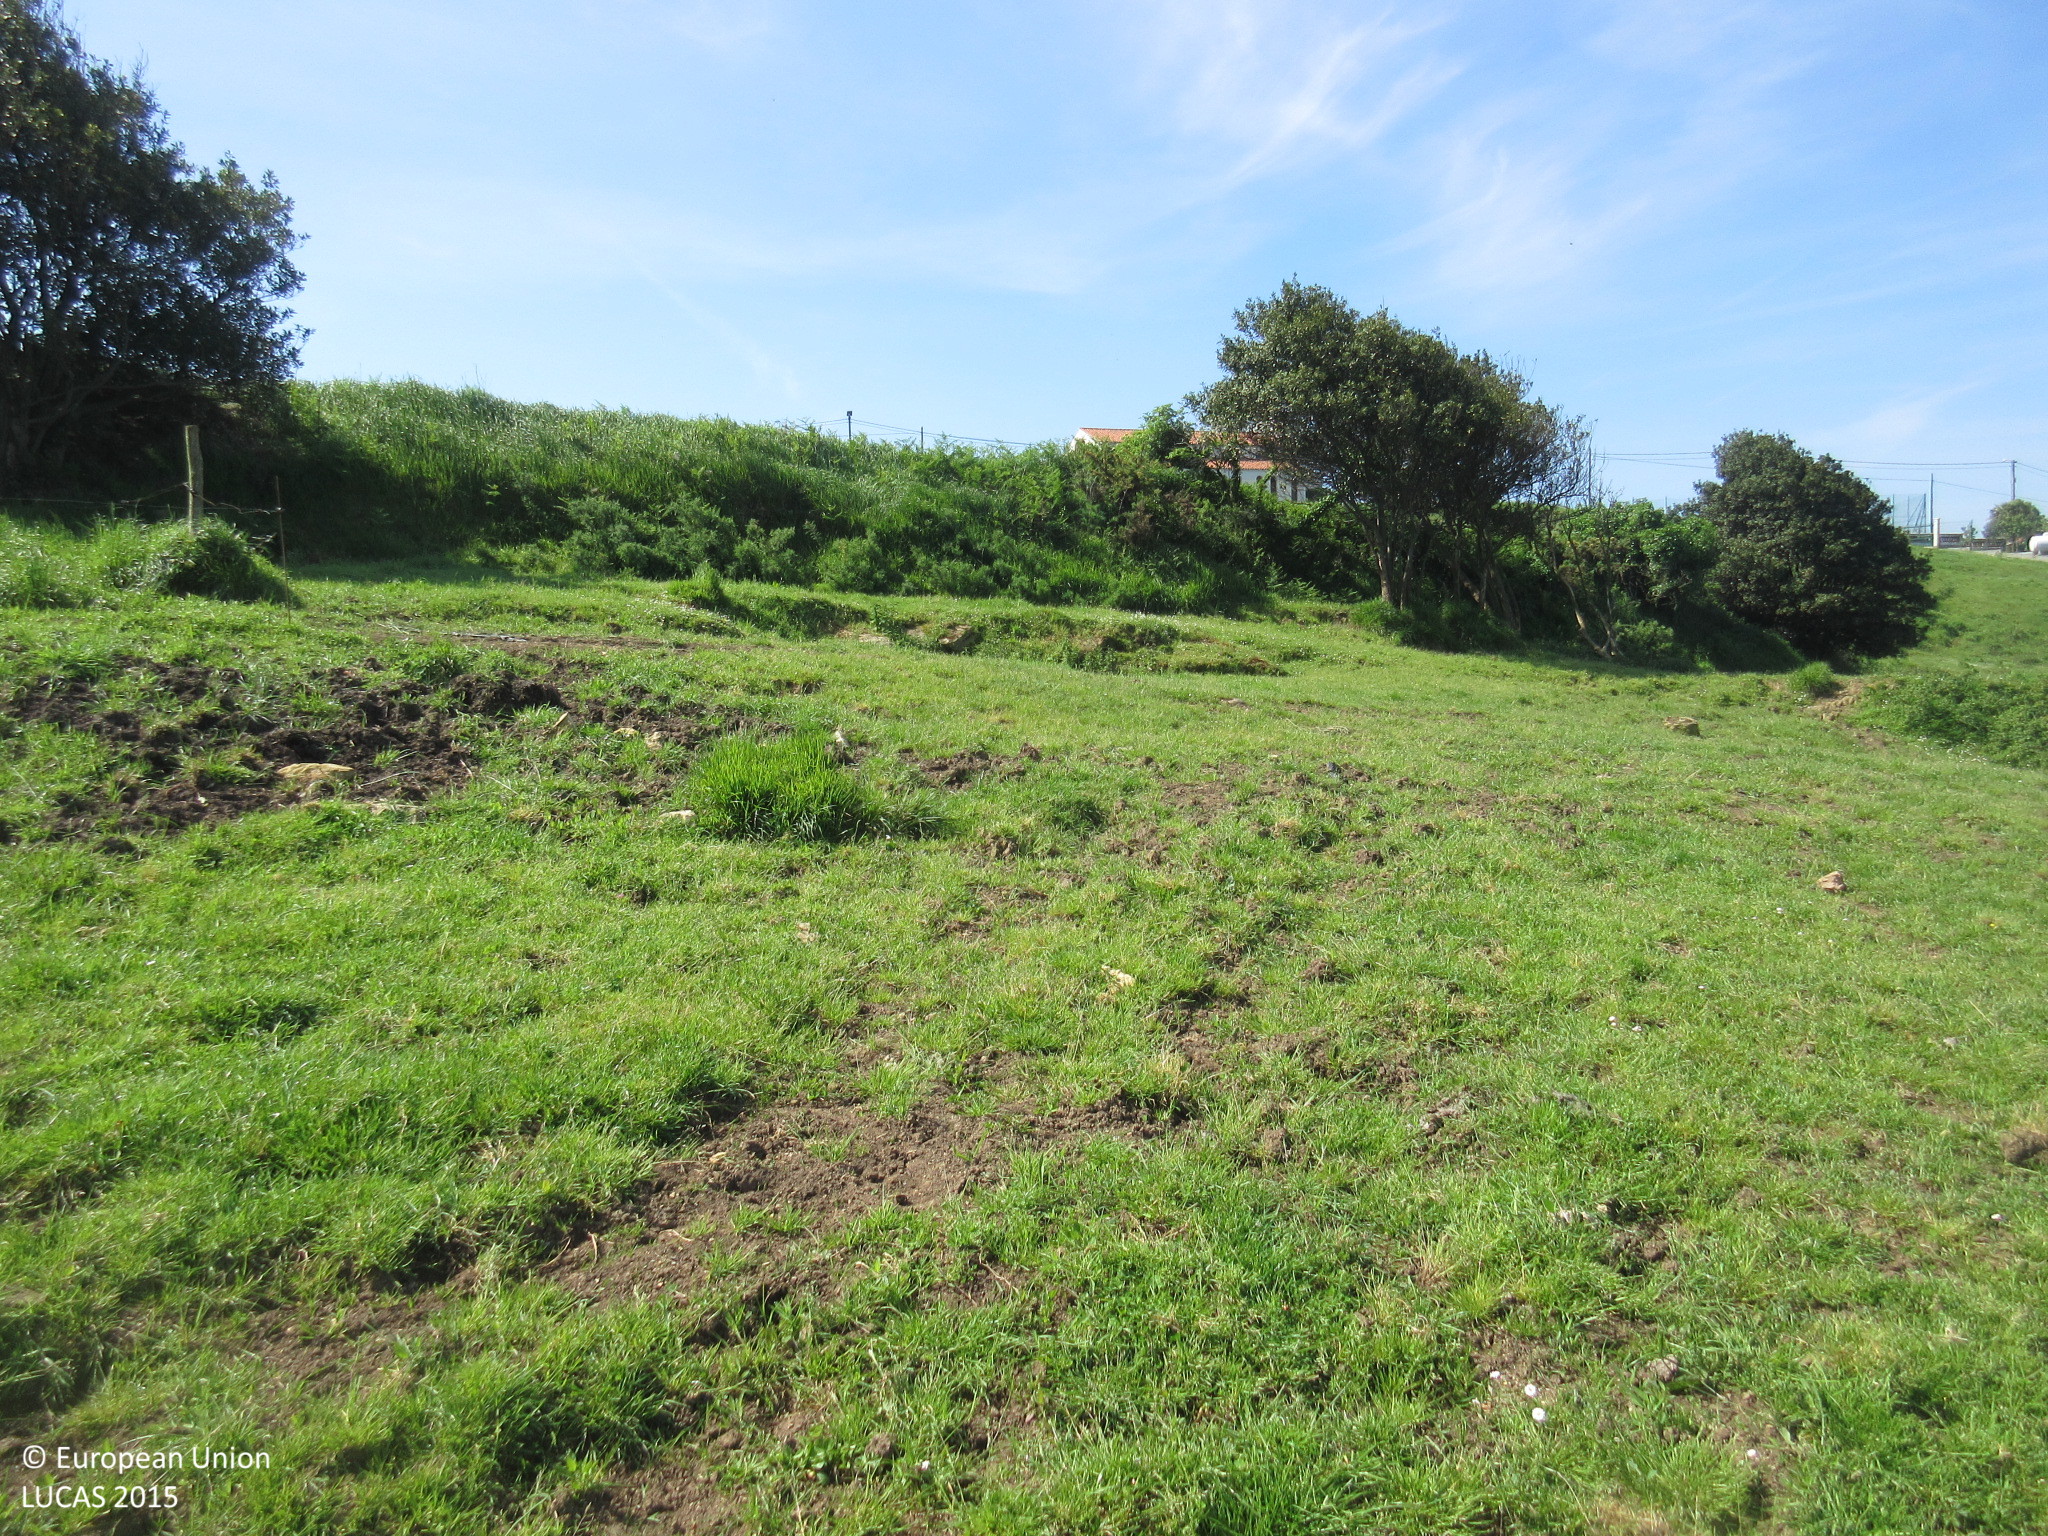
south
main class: Grassland
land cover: Grassland without tree/shrub cover
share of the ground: > 75 %
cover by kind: herbaceous plants 100 %
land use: Agriculture (excluding fallow land and kitchen gardens)
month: May
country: ES
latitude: 43.5911
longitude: -5.9087
